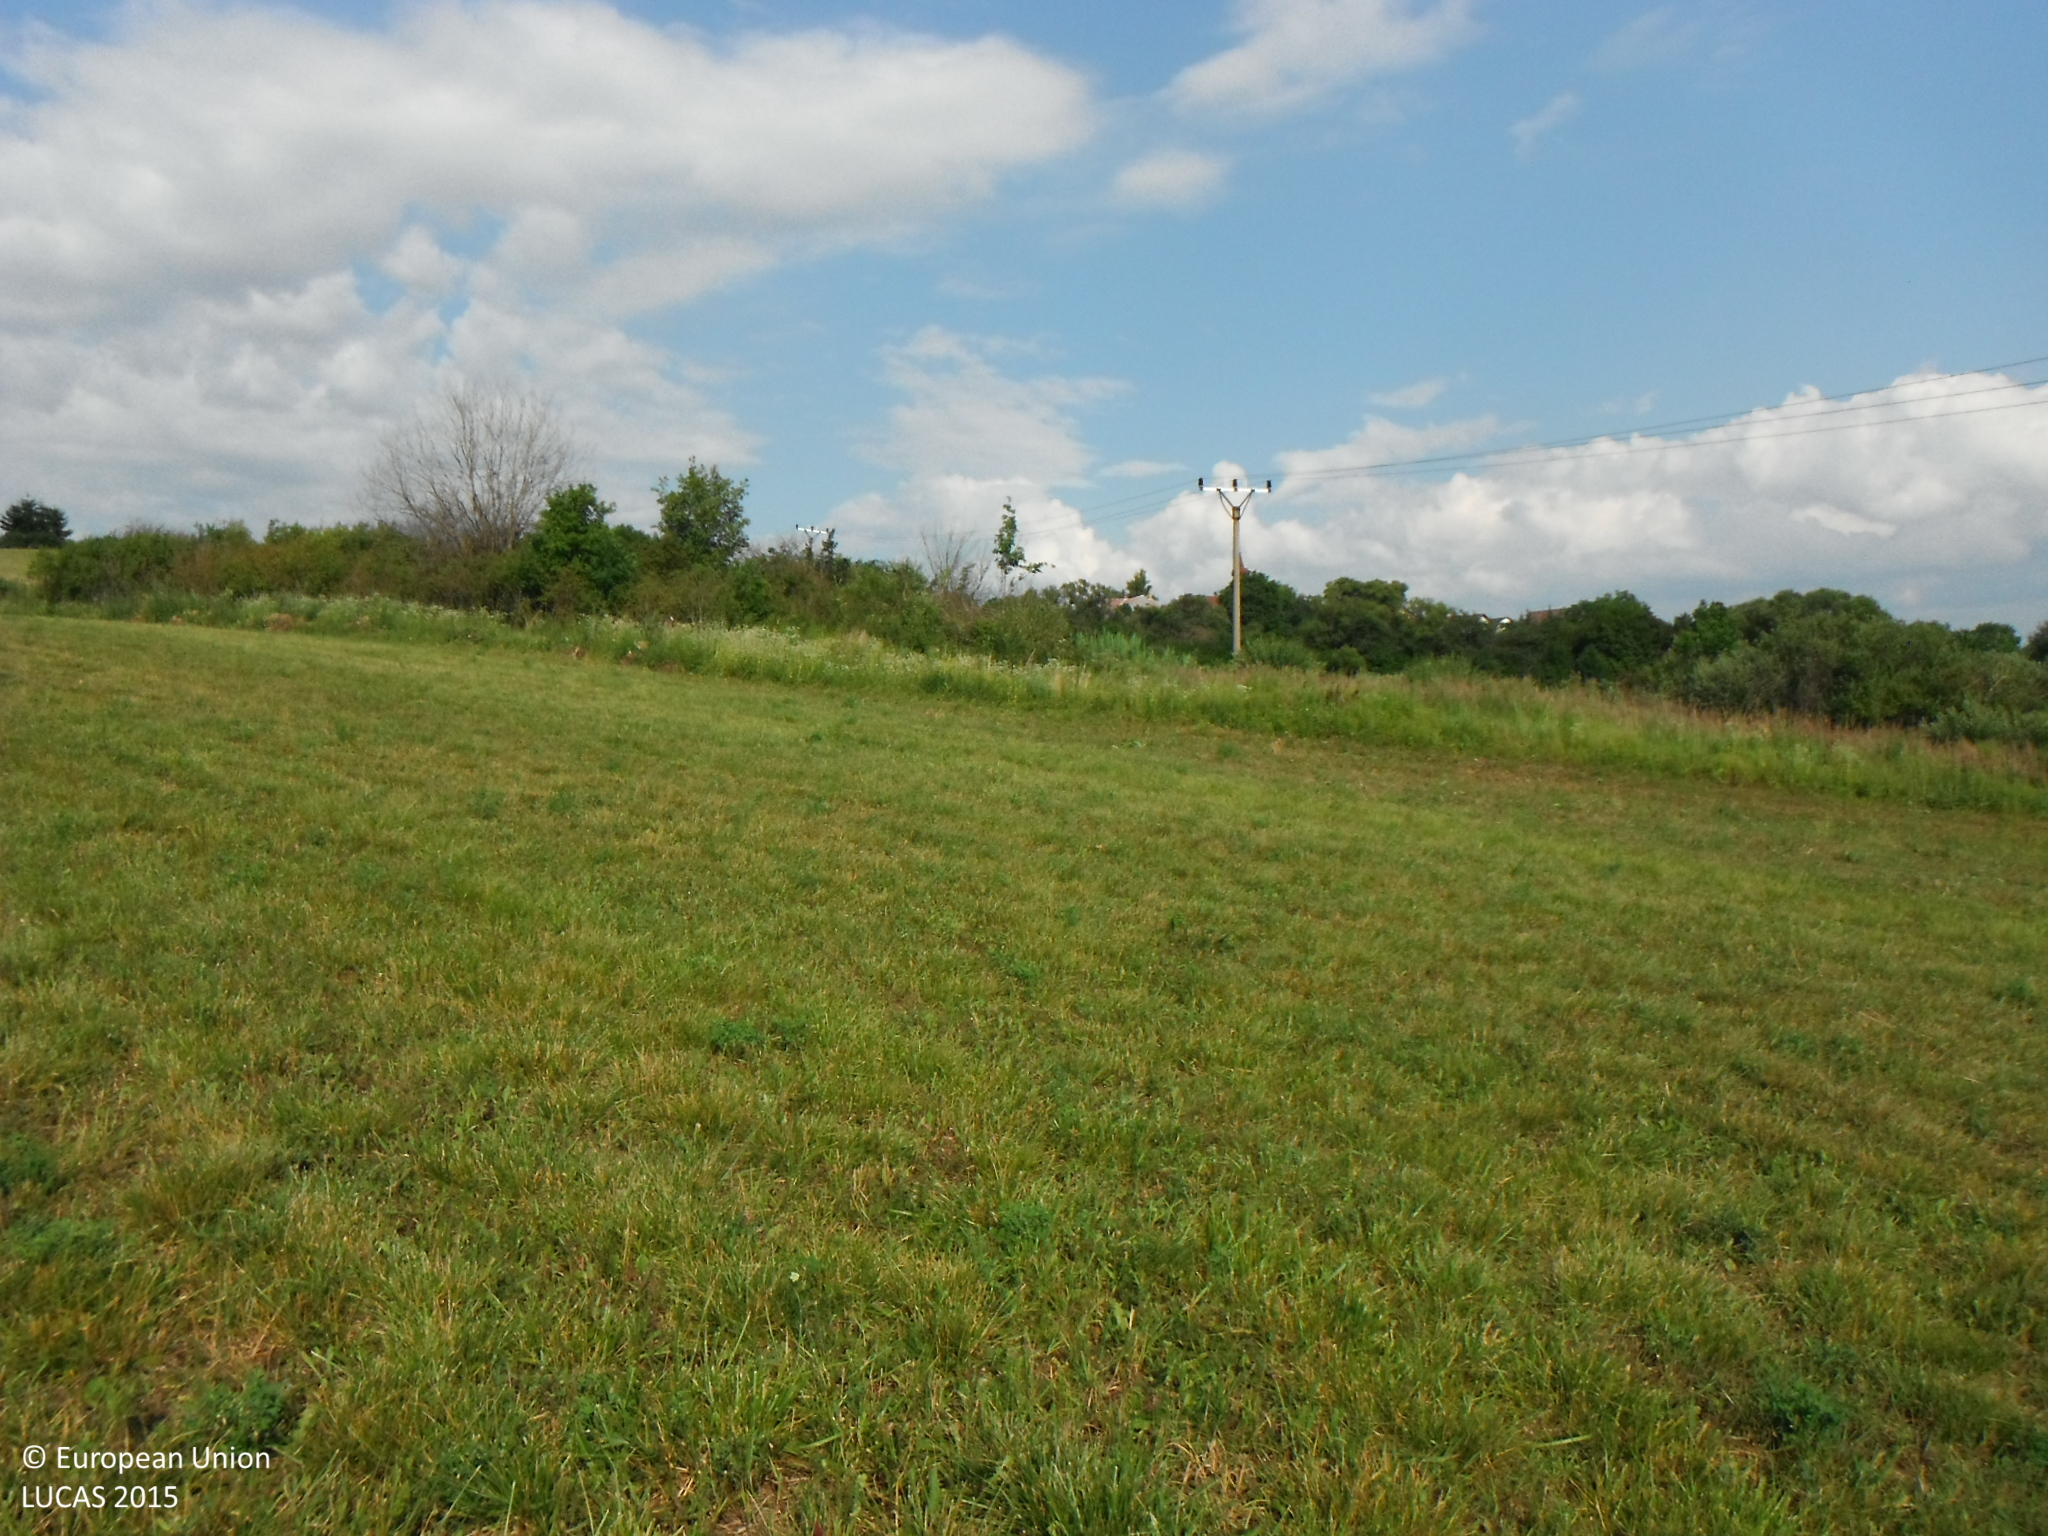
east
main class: Cropland
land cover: Other leguminous and mixtures for fodder
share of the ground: > 75 %
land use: Agriculture (excluding fallow land and kitchen gardens)
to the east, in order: Other leguminous and mixtures for fodder; Spontaneously vegetated surfaces; Shrubland with sparse tree cover; Grassland without tree/shrub cover; Electric lines; Grassland without tree/shrub cover; Shrubland without tree cover; Broadleaved woodland
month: July
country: SK
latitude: 48.6357
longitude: 21.5143
